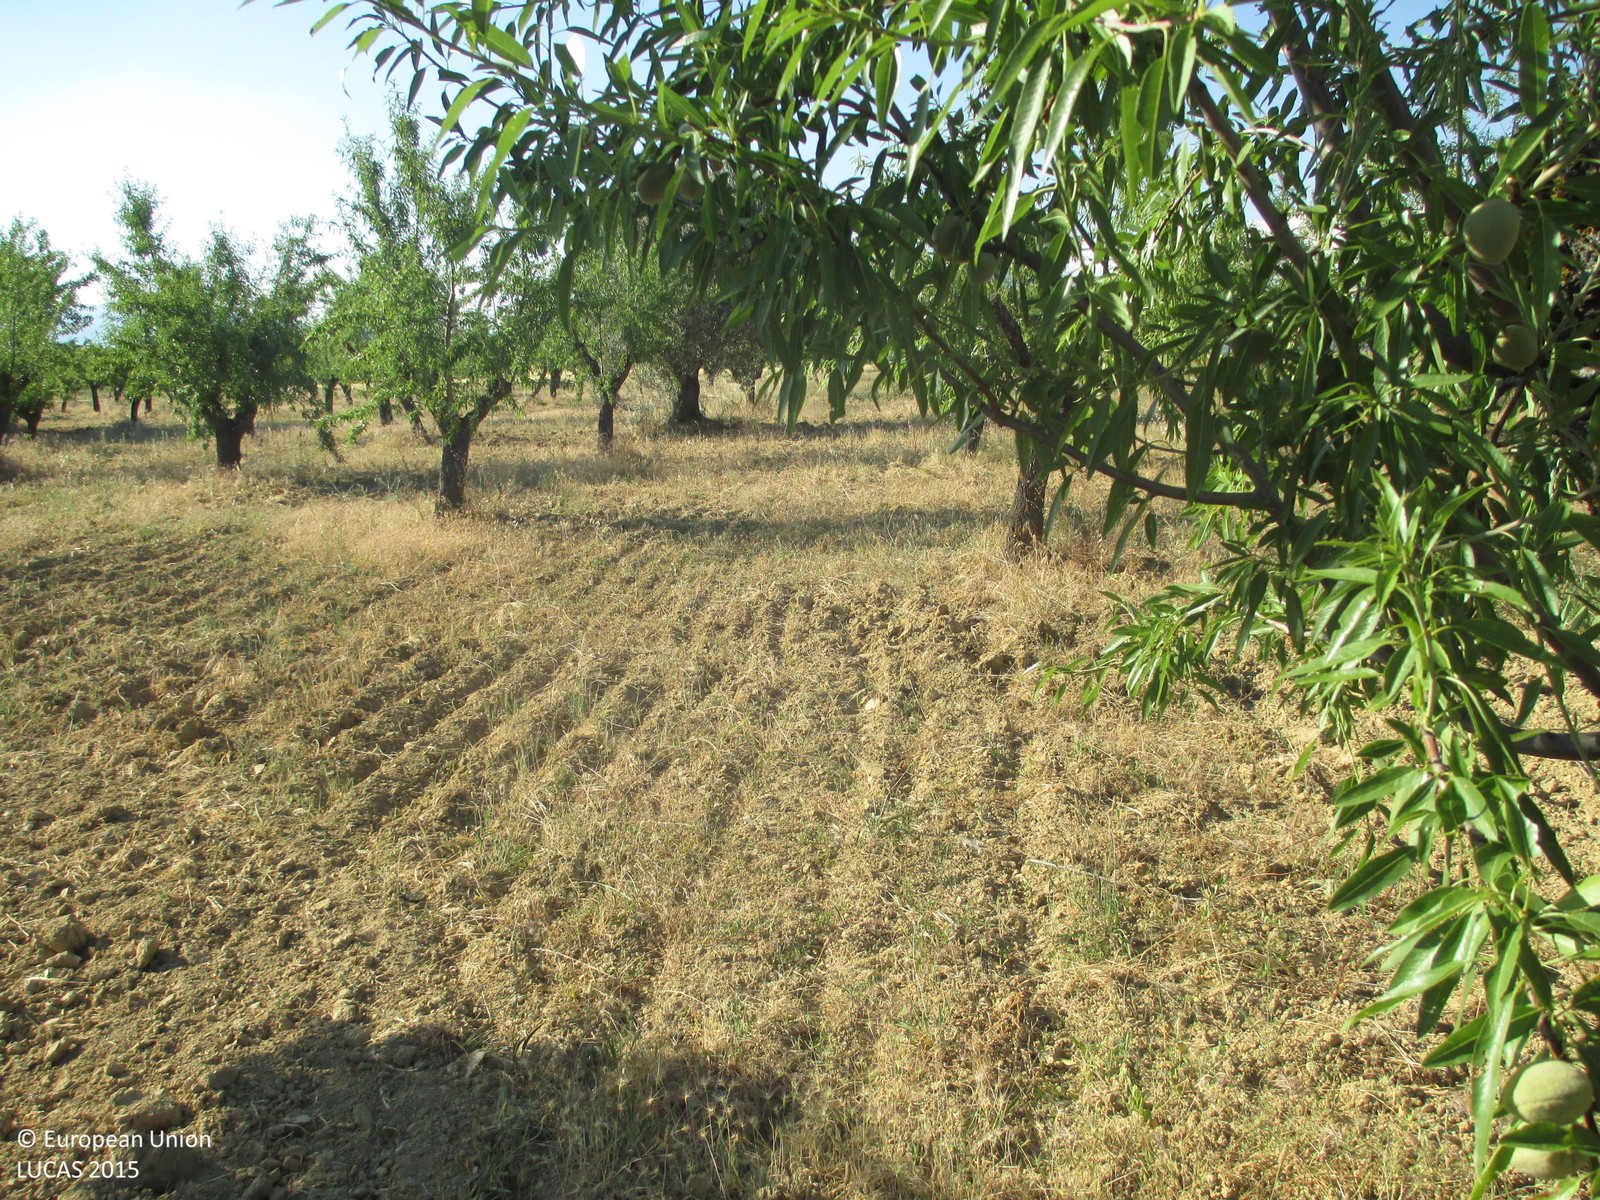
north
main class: Cropland
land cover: Nuts trees
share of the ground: 50 - 75 %
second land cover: Other bare soil
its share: > 75 %
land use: Agriculture (excluding fallow land and kitchen gardens)
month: June
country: ES
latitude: 42.1217
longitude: 0.0012
